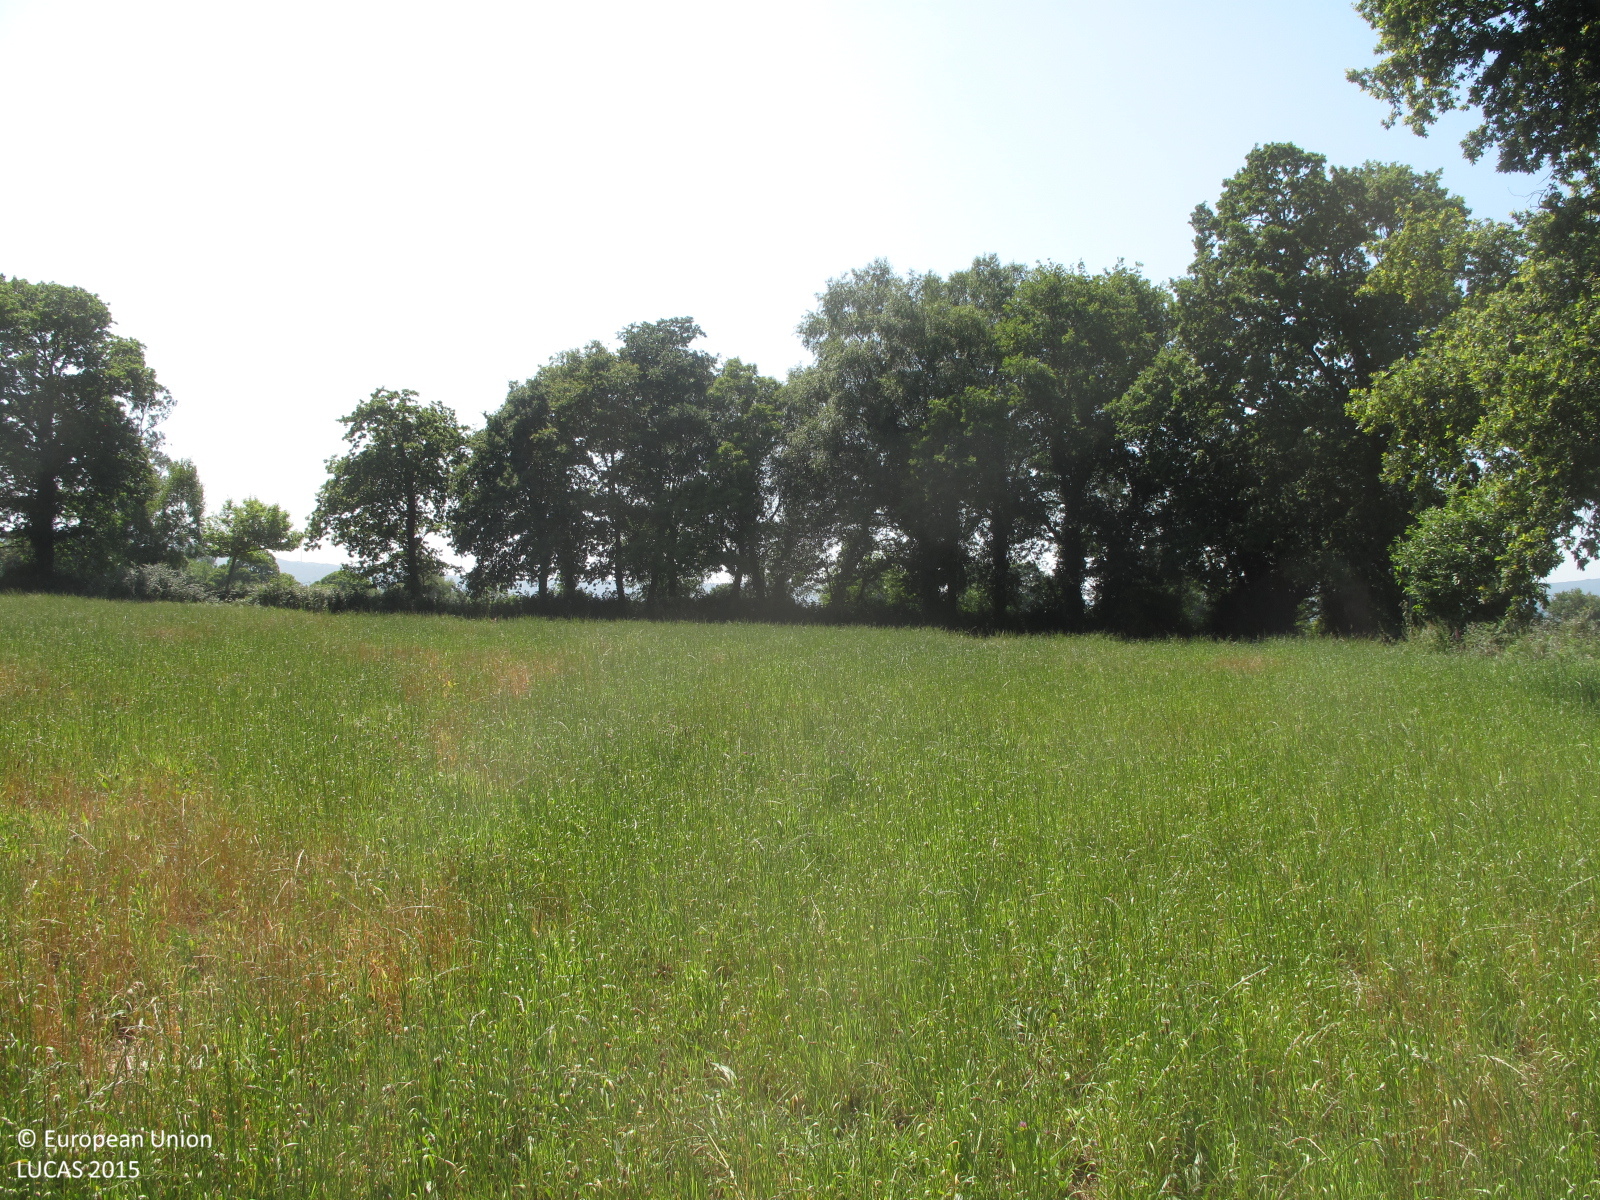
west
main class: Grassland
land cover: Grassland without tree/shrub cover
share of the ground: > 75 %
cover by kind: herbaceous plants 100 %
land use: Agriculture (excluding fallow land and kitchen gardens)
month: June
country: ES
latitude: 43.3035
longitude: -7.9550
